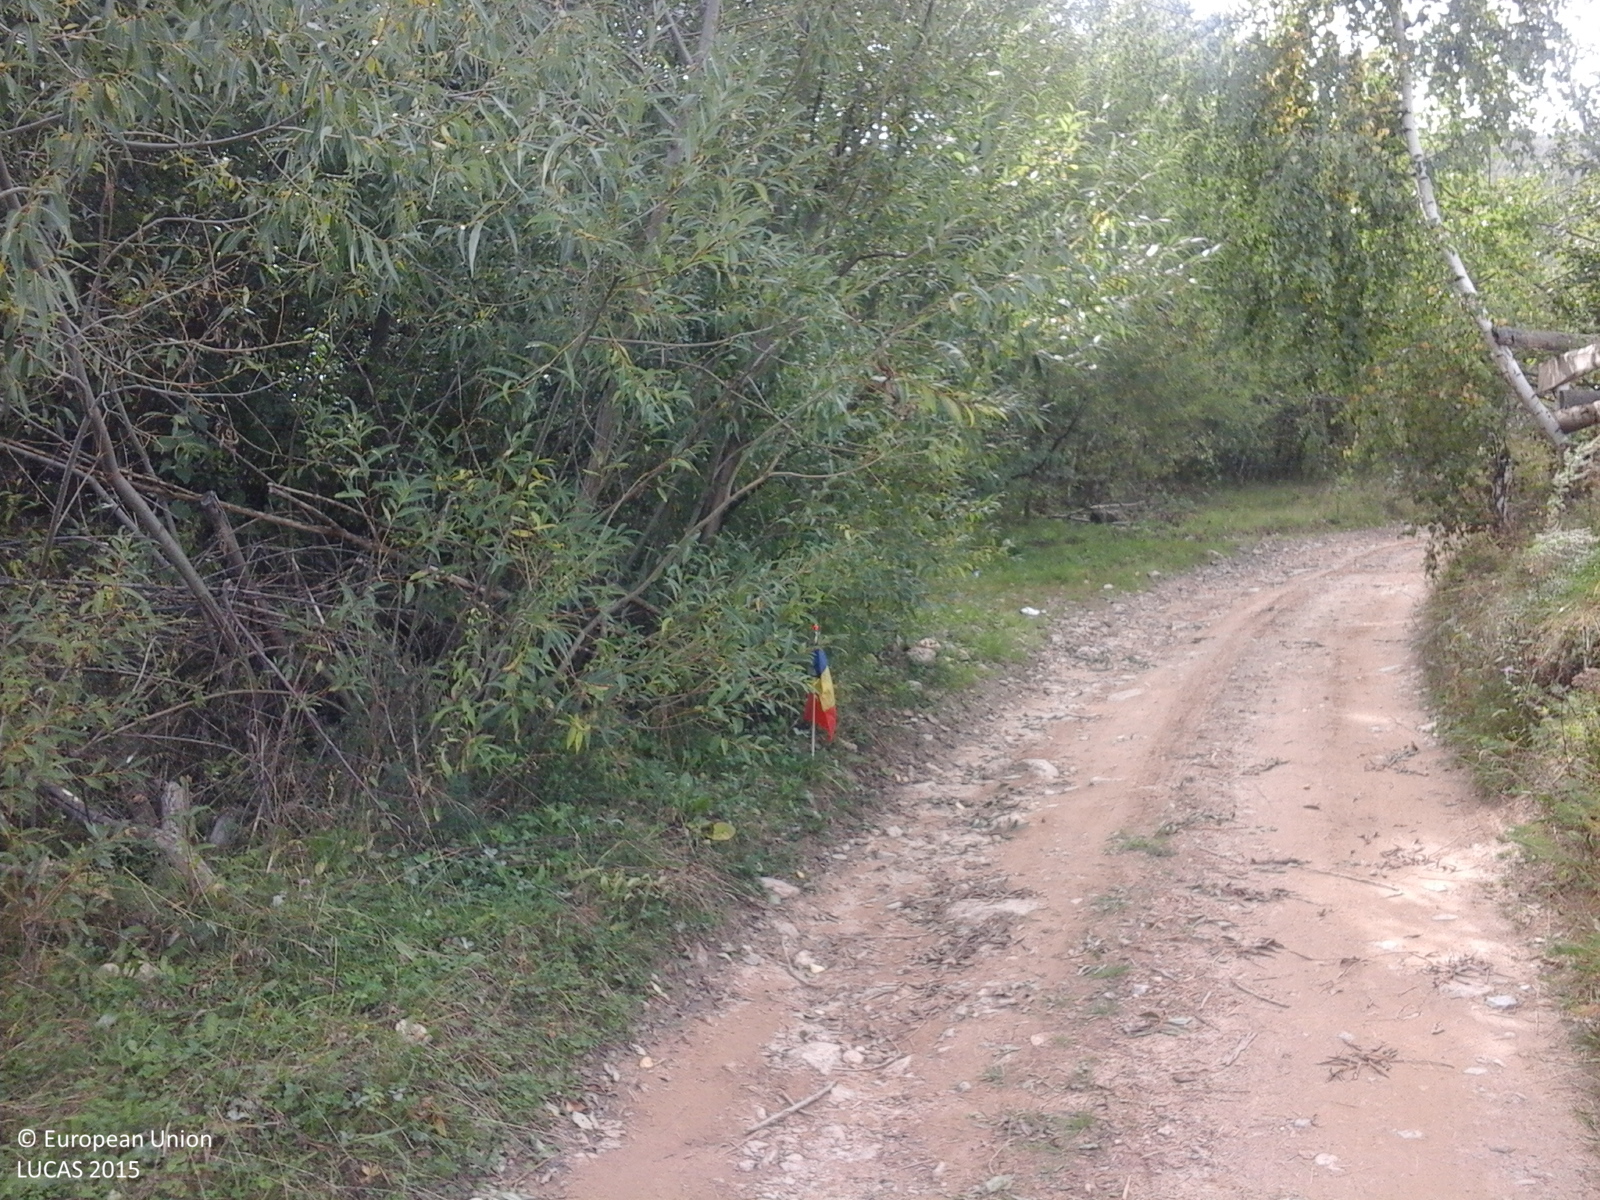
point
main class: Grassland
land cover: Grassland without tree/shrub cover
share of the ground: > 75 %
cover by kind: herbaceous plants 100 %
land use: Agriculture (excluding fallow land and kitchen gardens)
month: September
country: RO
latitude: 46.6649
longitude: 23.3050
